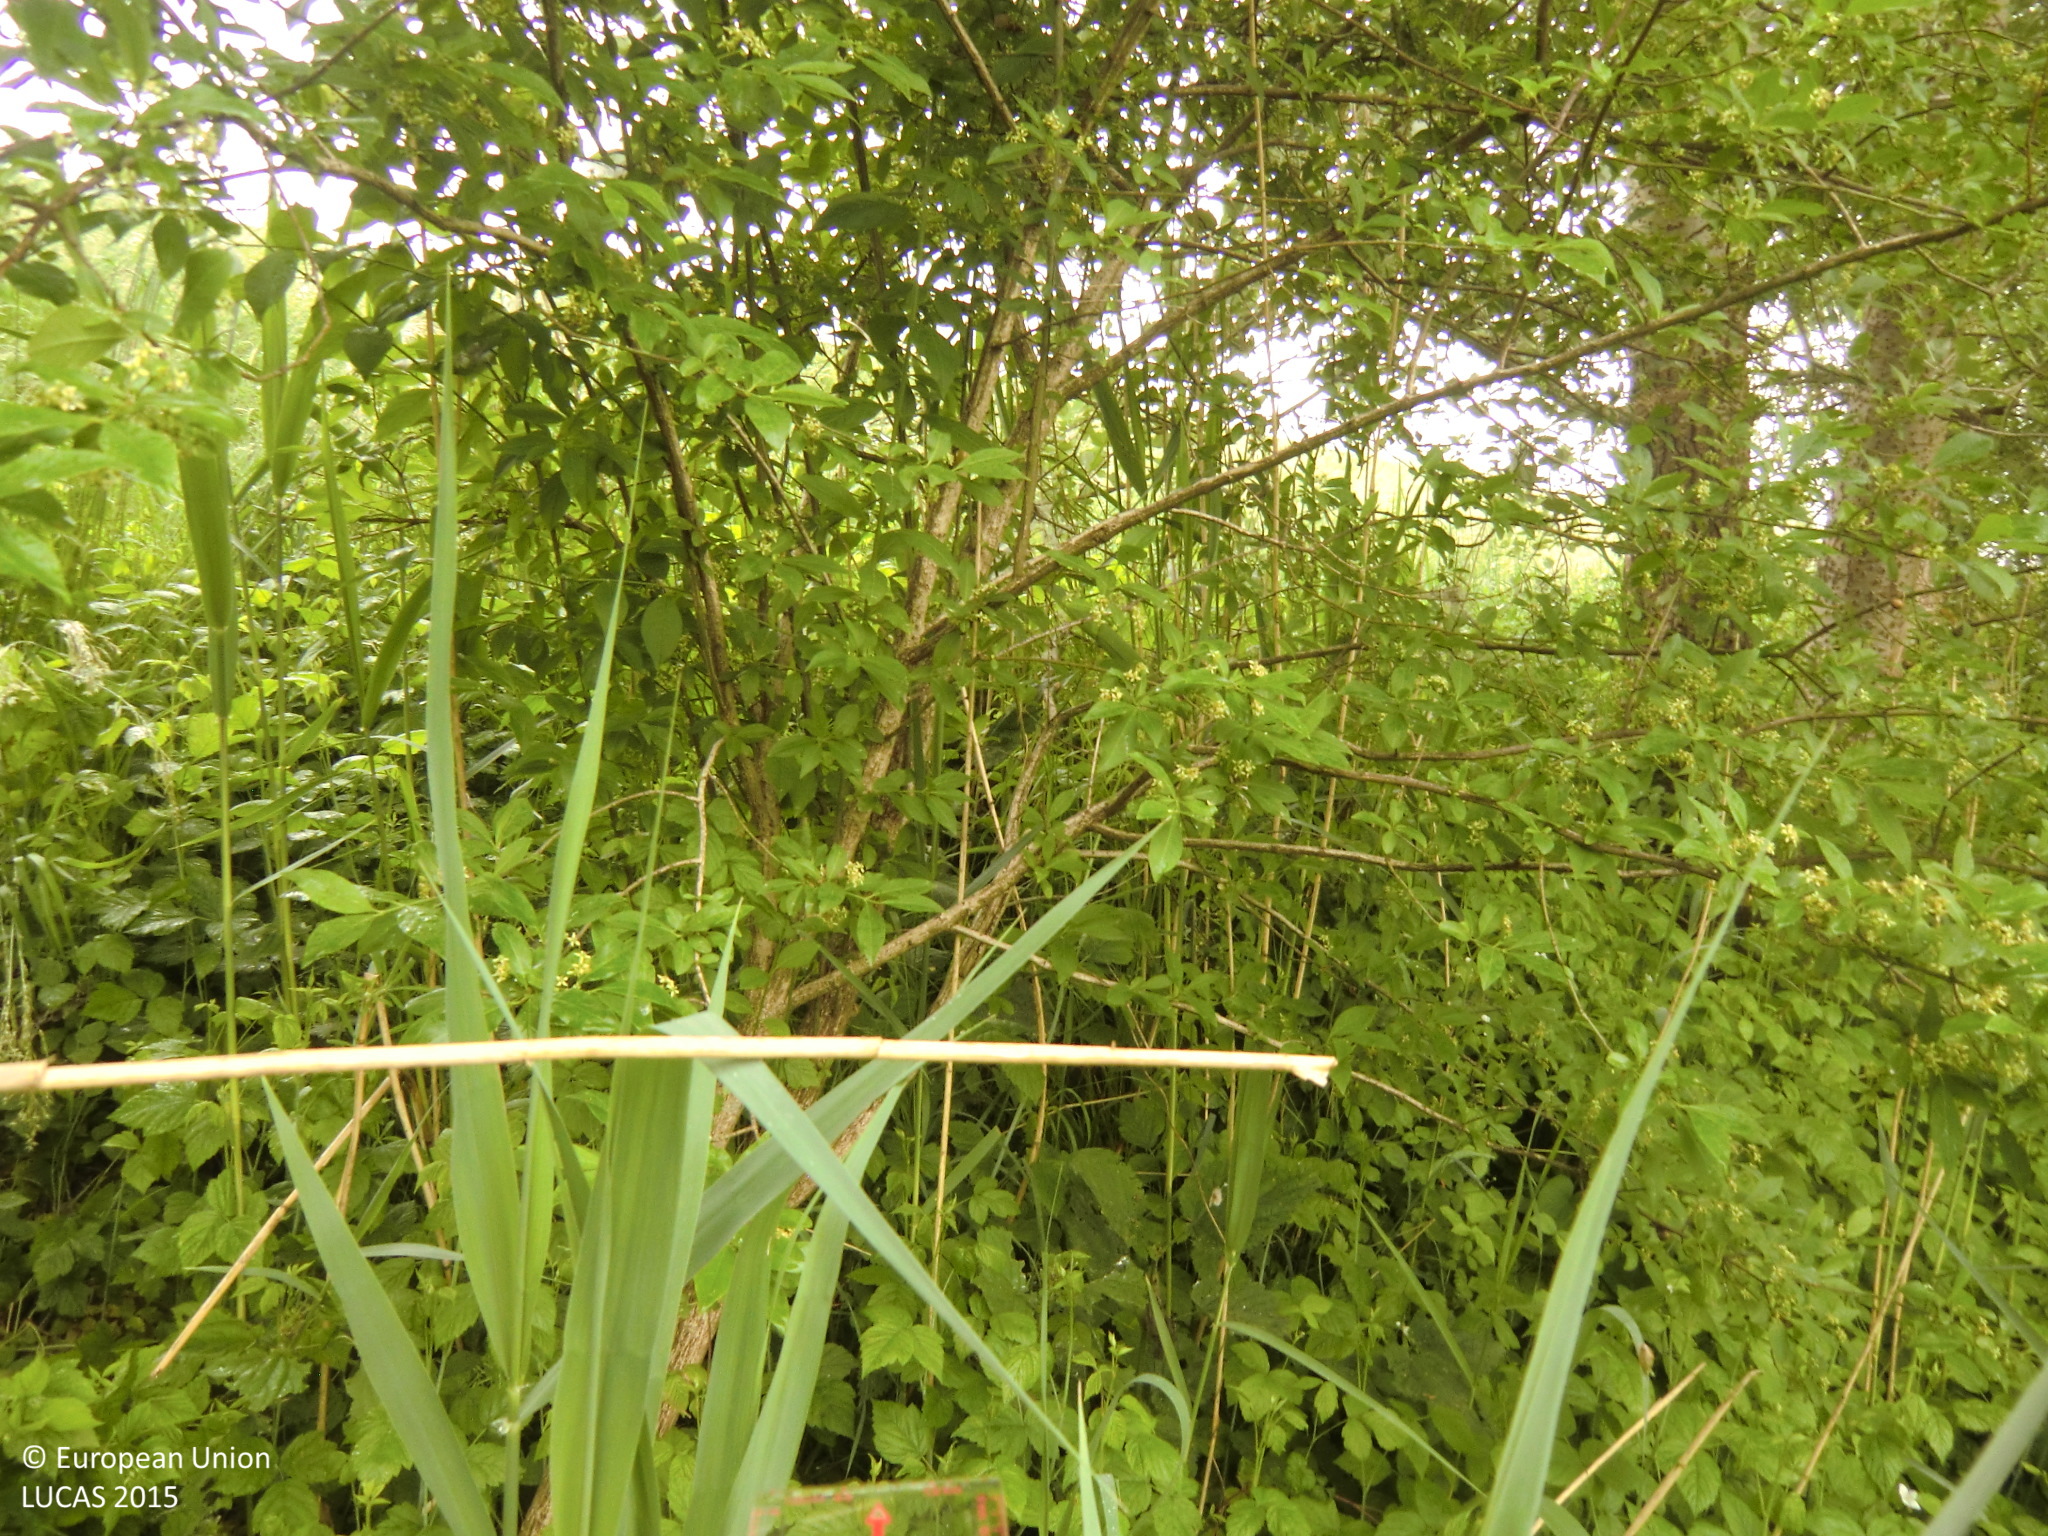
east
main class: Grassland
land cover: Grassland with sparse tree/shrub cover
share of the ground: > 75 %
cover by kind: herbaceous plants 95 %, broadleaved forest trees 5 %
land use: Semi-natural and natural areas not in use
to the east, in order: Grassland with sparse tree/shrub cover; Inland fresh running water; Shrubland with sparse tree cover; Broadleaved woodland; Tracks; Grassland without tree/shrub cover; Paved roads, cycling and walking lanes; Grass margins; Tracks; Grassland without tree/shrub cover; Barley; Grassland without tree/shrub cover; Broadleaved woodland; Railways; Broadleaved woodland; Grassland without tree/shrub cover; Artificial constructions in urban areas
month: May
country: AT
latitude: 48.2617
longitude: 14.4052
